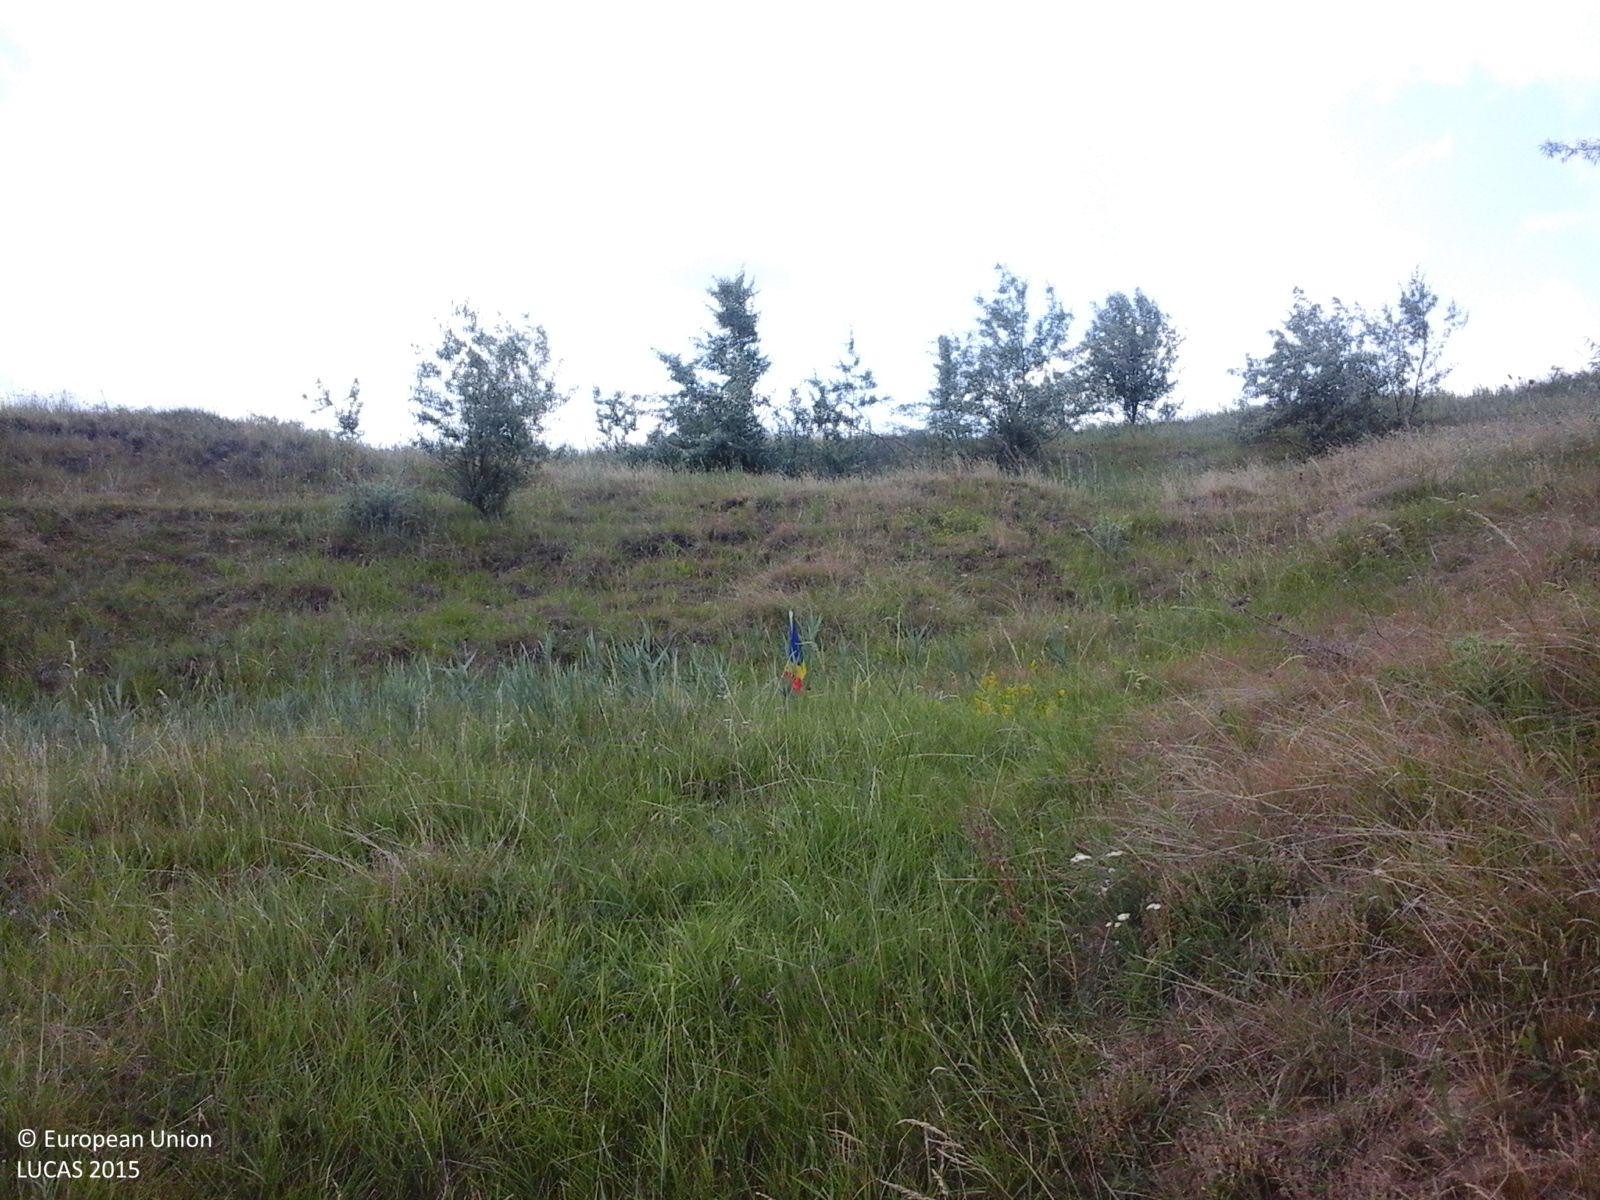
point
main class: Grassland
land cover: Grassland with sparse tree/shrub cover
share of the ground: > 75 %
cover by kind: herbaceous plants 90 %, broadleaved forest trees 5 %, shrubs 5 %
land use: Agriculture (excluding fallow land and kitchen gardens)
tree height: < 5 m
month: June
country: RO
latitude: 47.6712
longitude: 27.0605
